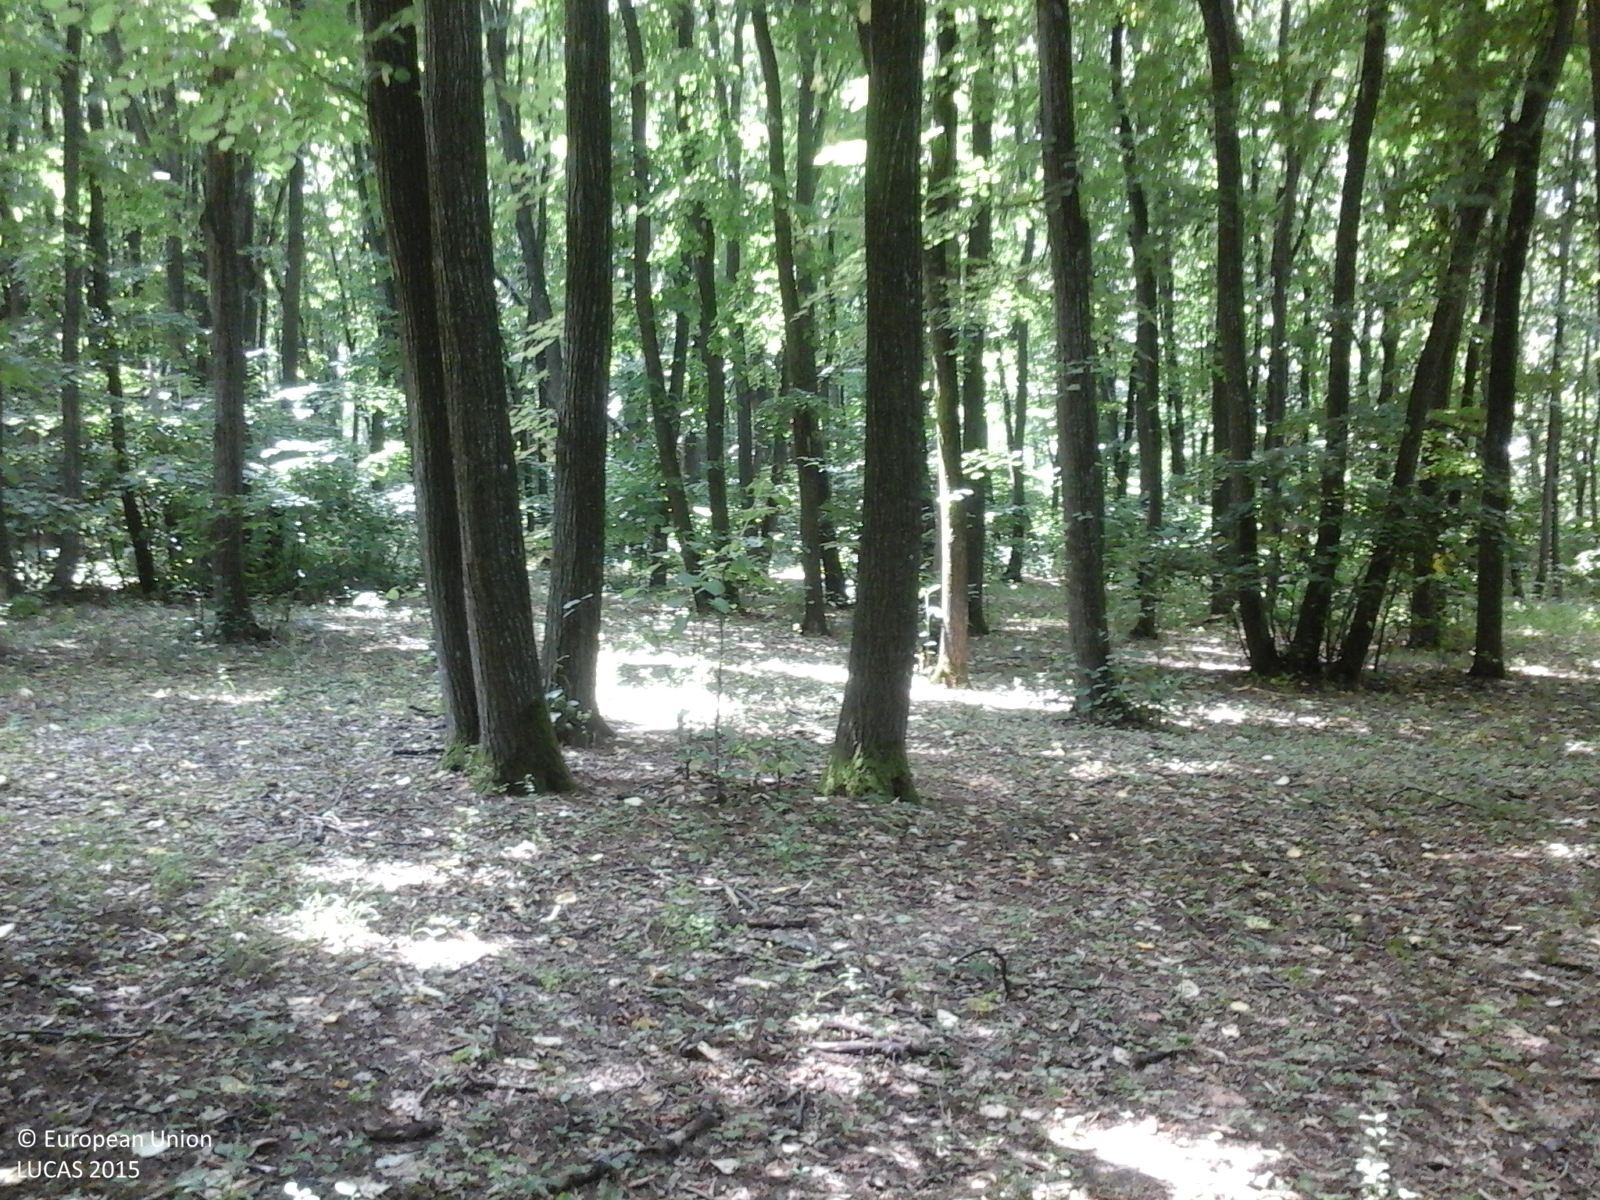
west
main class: Woodland
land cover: Broadleaved woodland
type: thermophilous deciduous forest
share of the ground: > 75 %
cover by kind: broadleaved forest trees 100 %
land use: Forestry
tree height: > 5 m
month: June
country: RO
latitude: 44.1537
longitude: 26.2986
